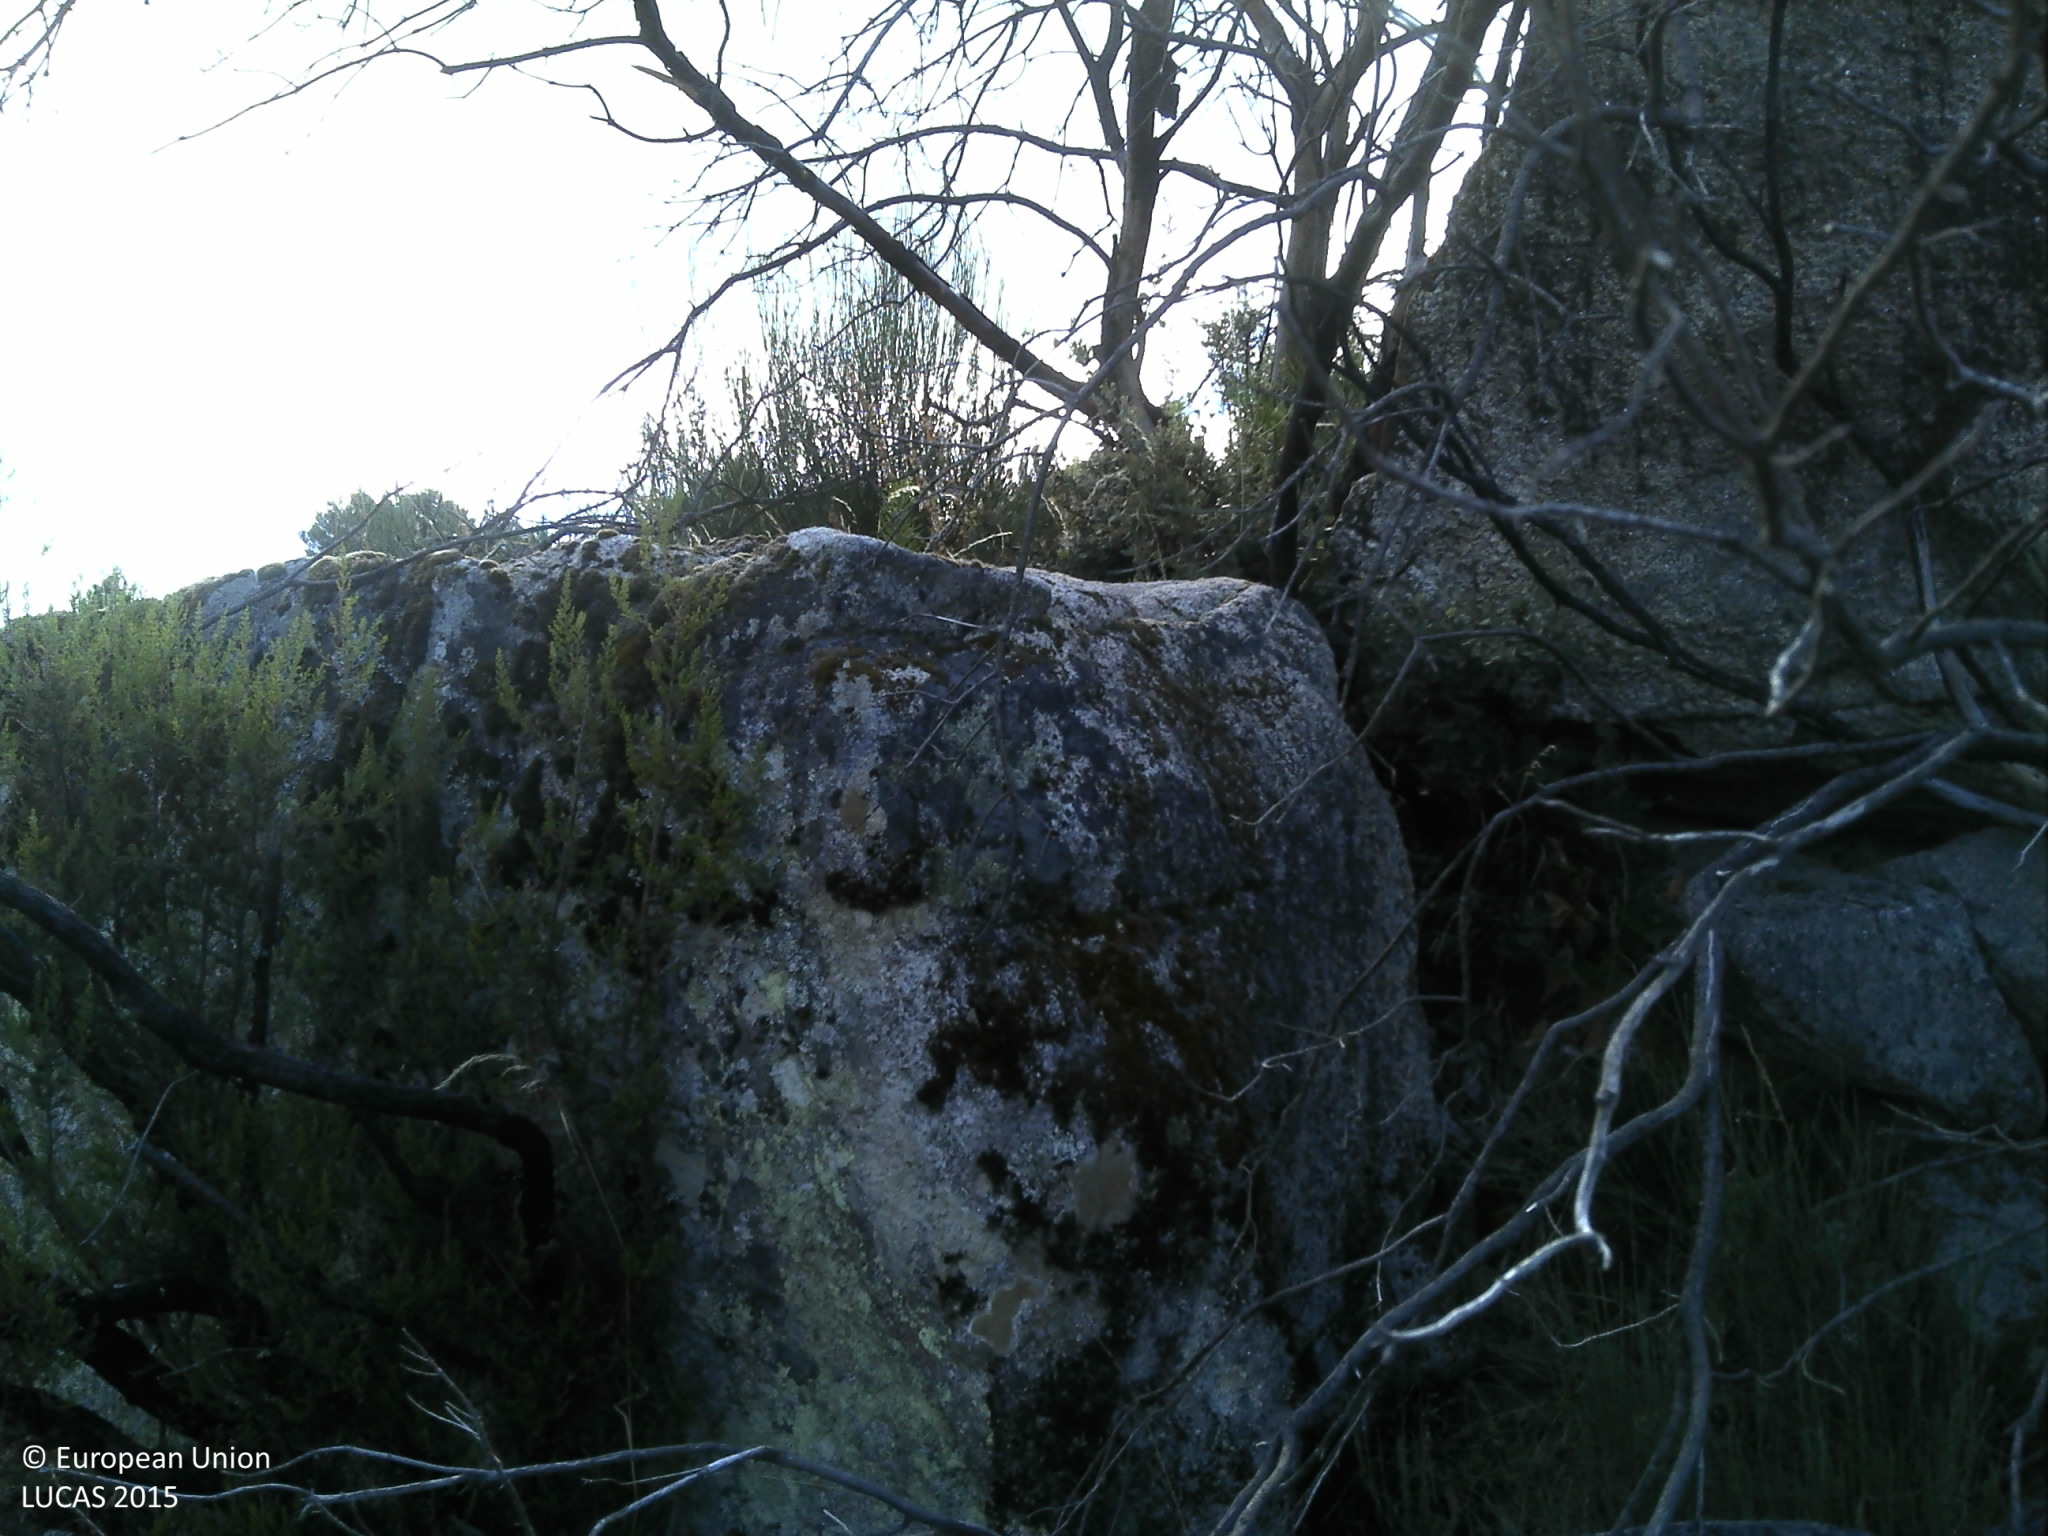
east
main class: Shrubland
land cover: Shrubland with sparse tree cover
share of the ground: 25 - 50 %
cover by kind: shrubs 45 %, herbaceous plants 25 %, consolidated bare surface 20 %, coniferous forest trees 5 %, unconsolidated bare surface 5 %
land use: Semi-natural and natural areas not in use
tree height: > 5 m
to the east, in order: Shrubland with sparse tree cover; Rocks and stones; Shrubland without tree cover; Pine dominated coniferous woodland; Shrubland without tree cover; Tracks; Shrubland without tree cover; Rock outcrops; Shrubland without tree cover; Rocks and stones; Tracks; Shrubland without tree cover; Dry stone walls; Shrubland without tree cover
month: July
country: PT
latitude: 41.2780
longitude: -7.4210
